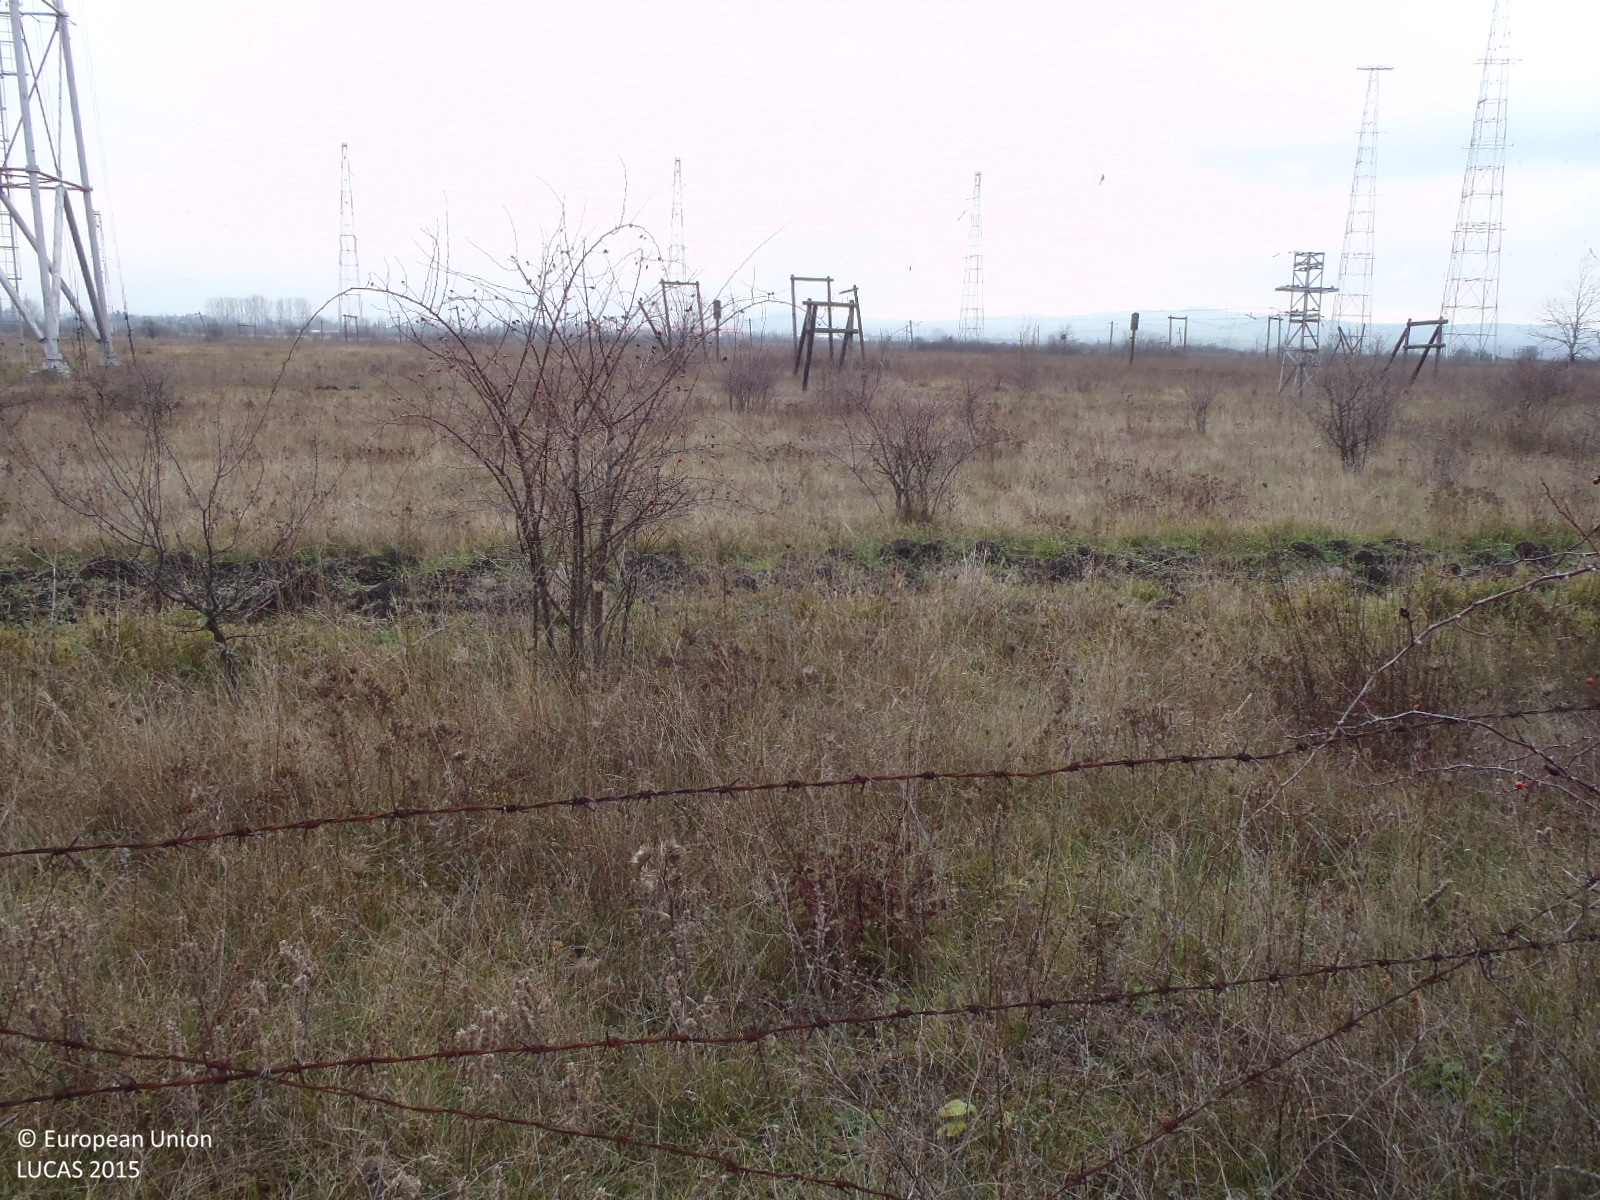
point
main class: Grassland
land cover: Grassland with sparse tree/shrub cover
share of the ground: > 75 %
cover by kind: herbaceous plants 85 %, shrubs 10 %, broadleaved forest trees 5 %
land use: Community services
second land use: Telecommunication
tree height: < 5 m
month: December
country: BG
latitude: 42.8118
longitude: 23.1800
